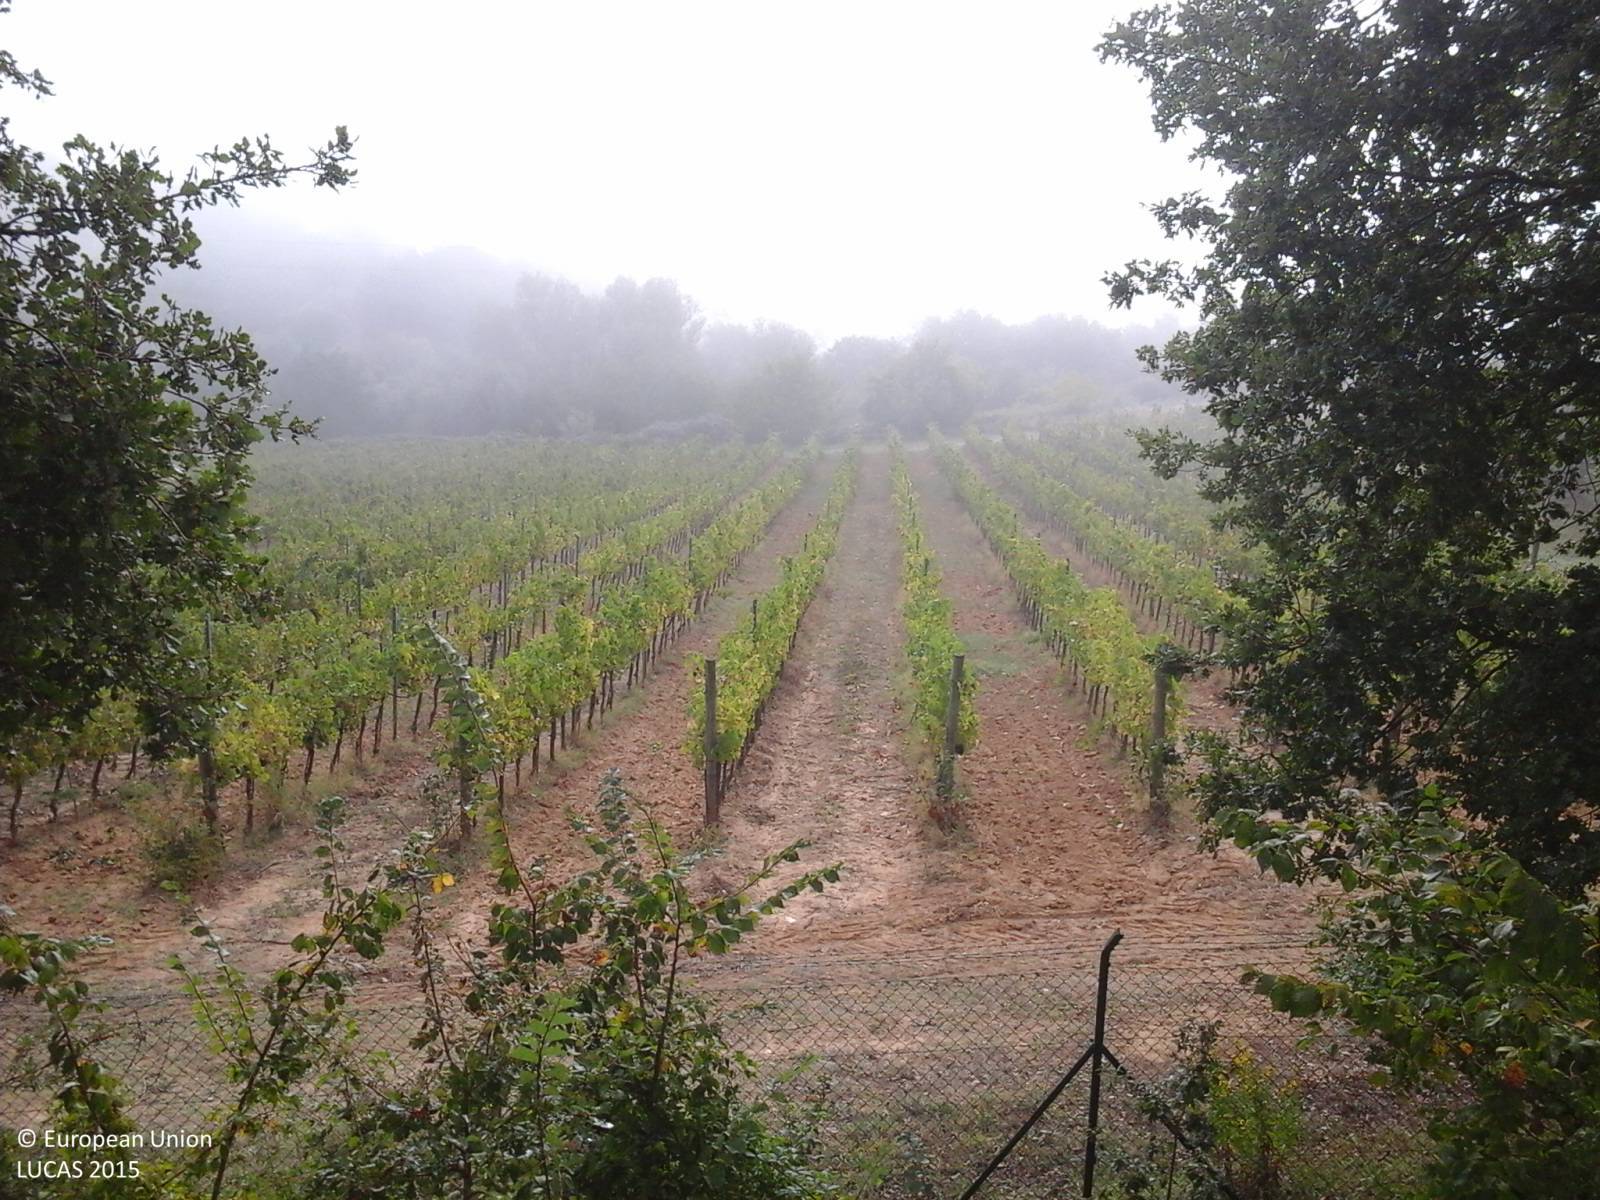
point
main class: Cropland
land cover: Vineyards
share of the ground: 25 - 50 %
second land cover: Grassland without tree/shrub cover
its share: > 75 %
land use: Agriculture (excluding fallow land and kitchen gardens)
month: September
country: IT
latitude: 42.9035
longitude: 12.0879
